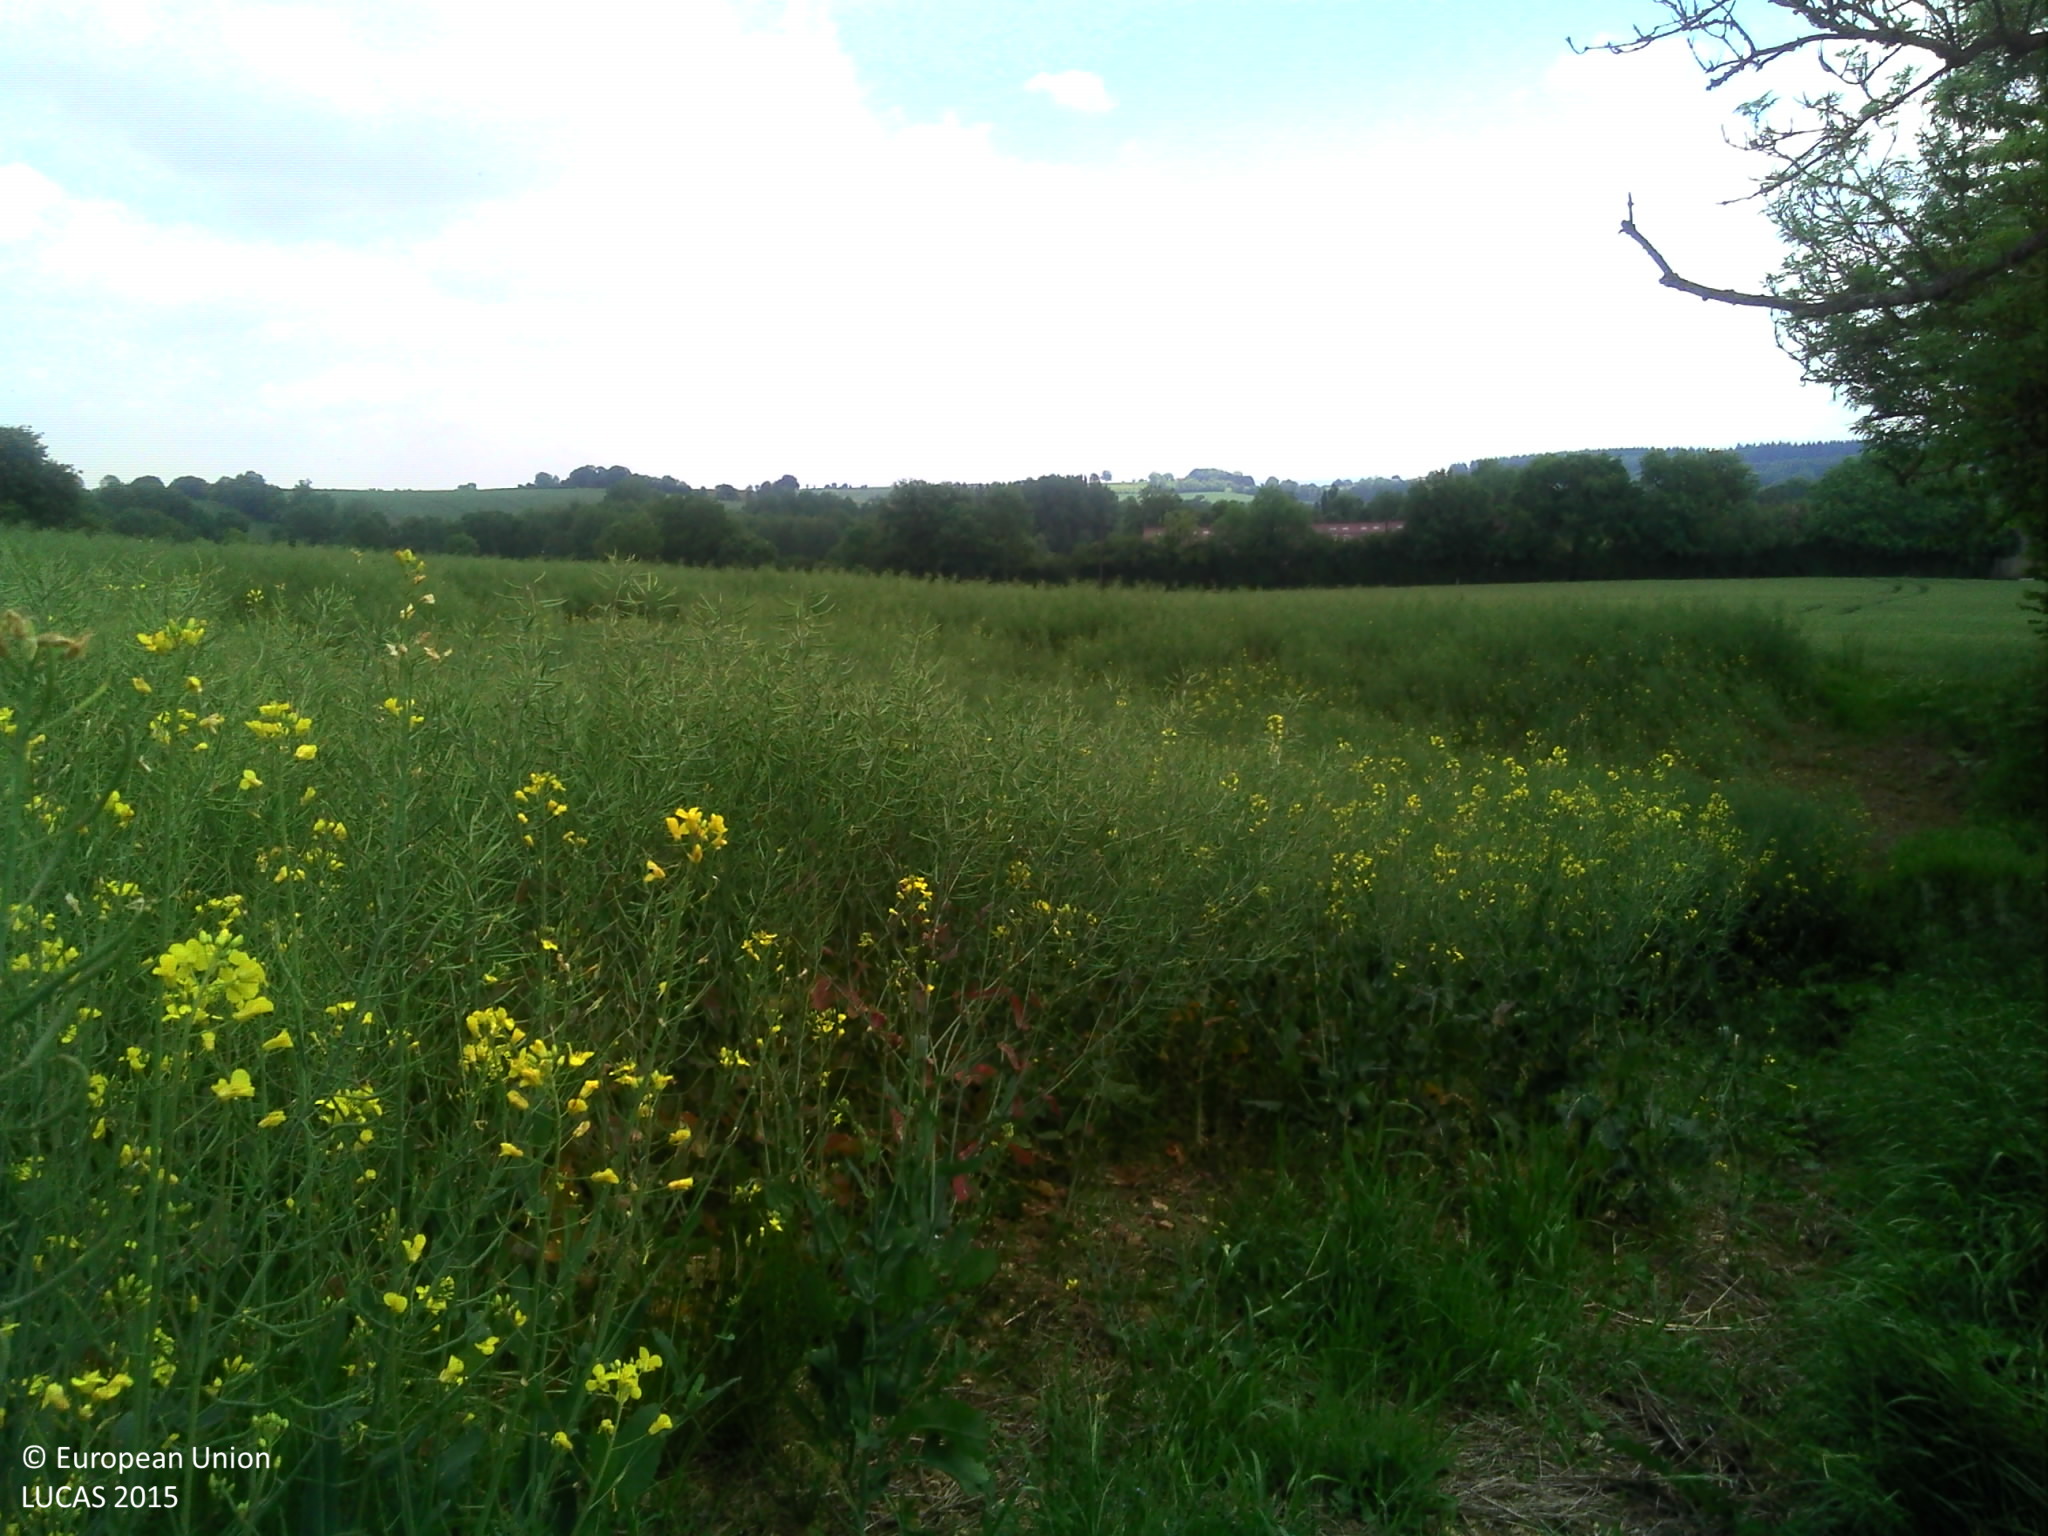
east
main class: Cropland
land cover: Rape and turnip rape
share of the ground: > 75 %
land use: Agriculture (excluding fallow land and kitchen gardens)
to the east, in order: Grass margins; Rape and turnip rape; Grass margins; Common wheat
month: May
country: FR
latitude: 48.7677
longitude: -0.1681
